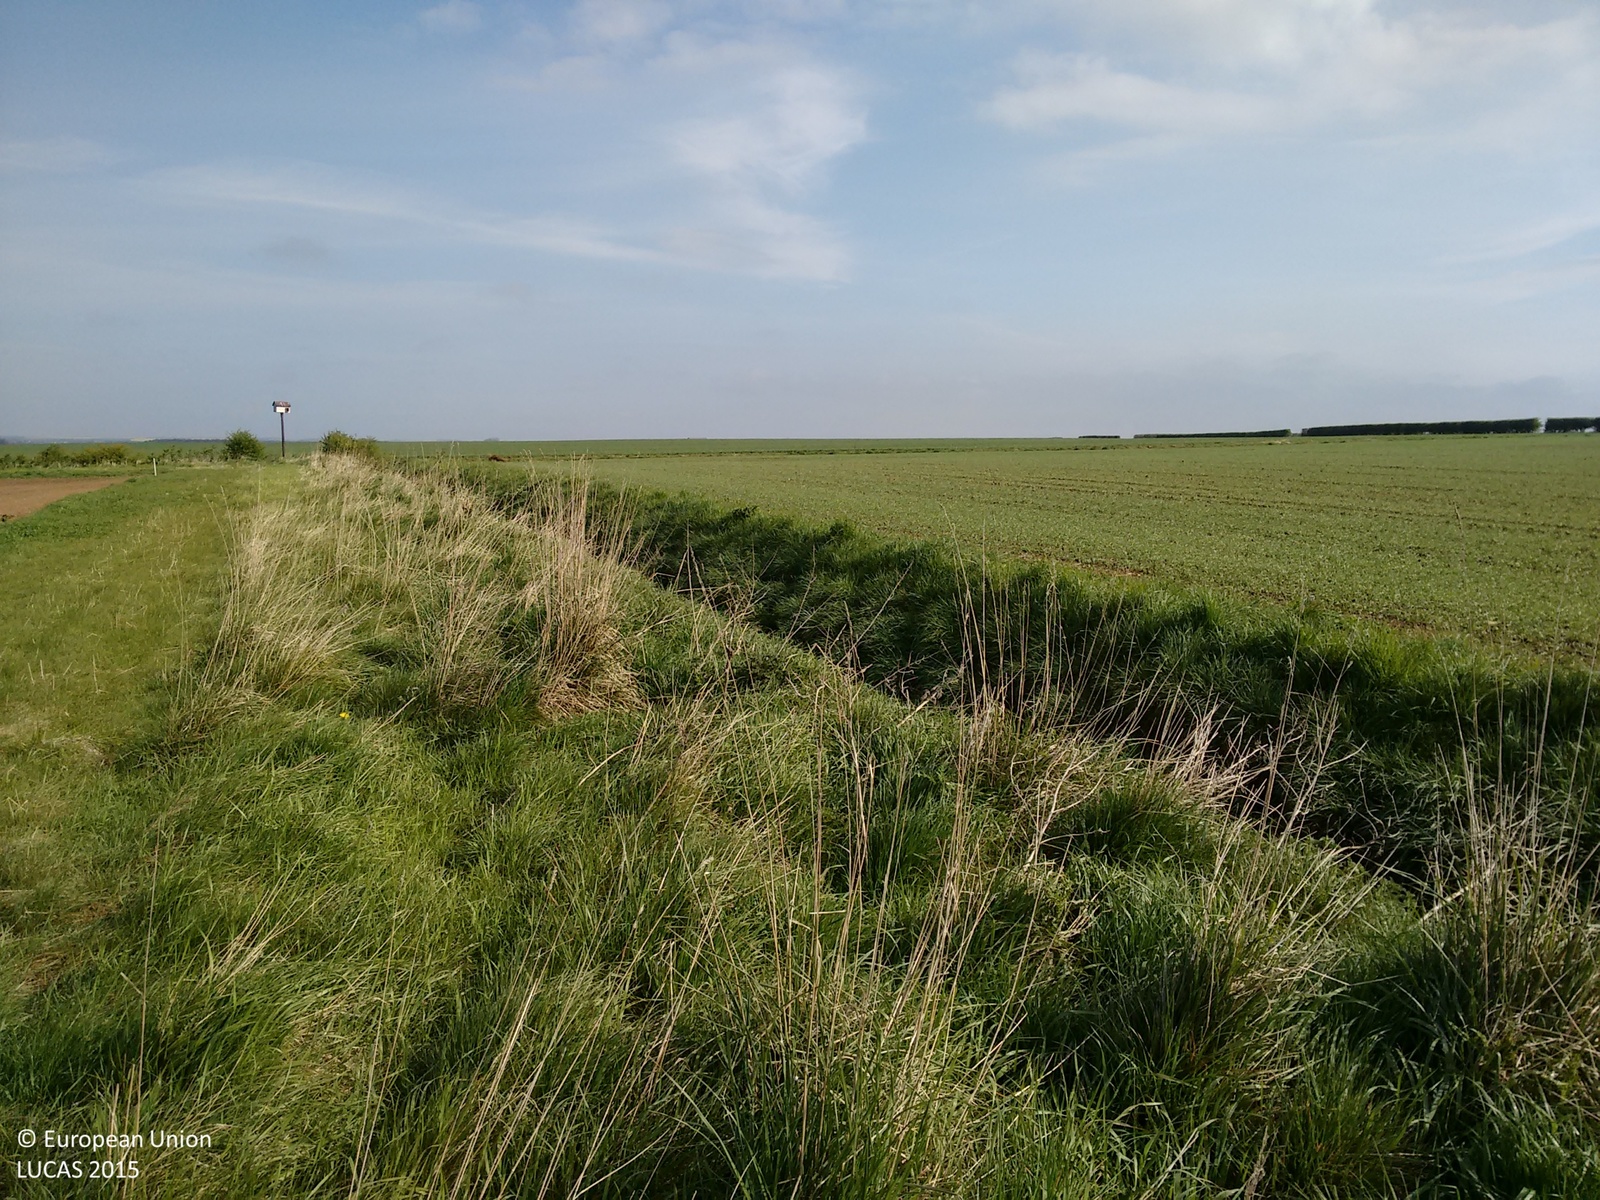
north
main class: Grassland
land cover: Grassland without tree/shrub cover
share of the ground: > 75 %
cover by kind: herbaceous plants 100 %
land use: Agriculture (excluding fallow land and kitchen gardens)
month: May
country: GB
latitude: 53.9924
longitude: -0.3303
